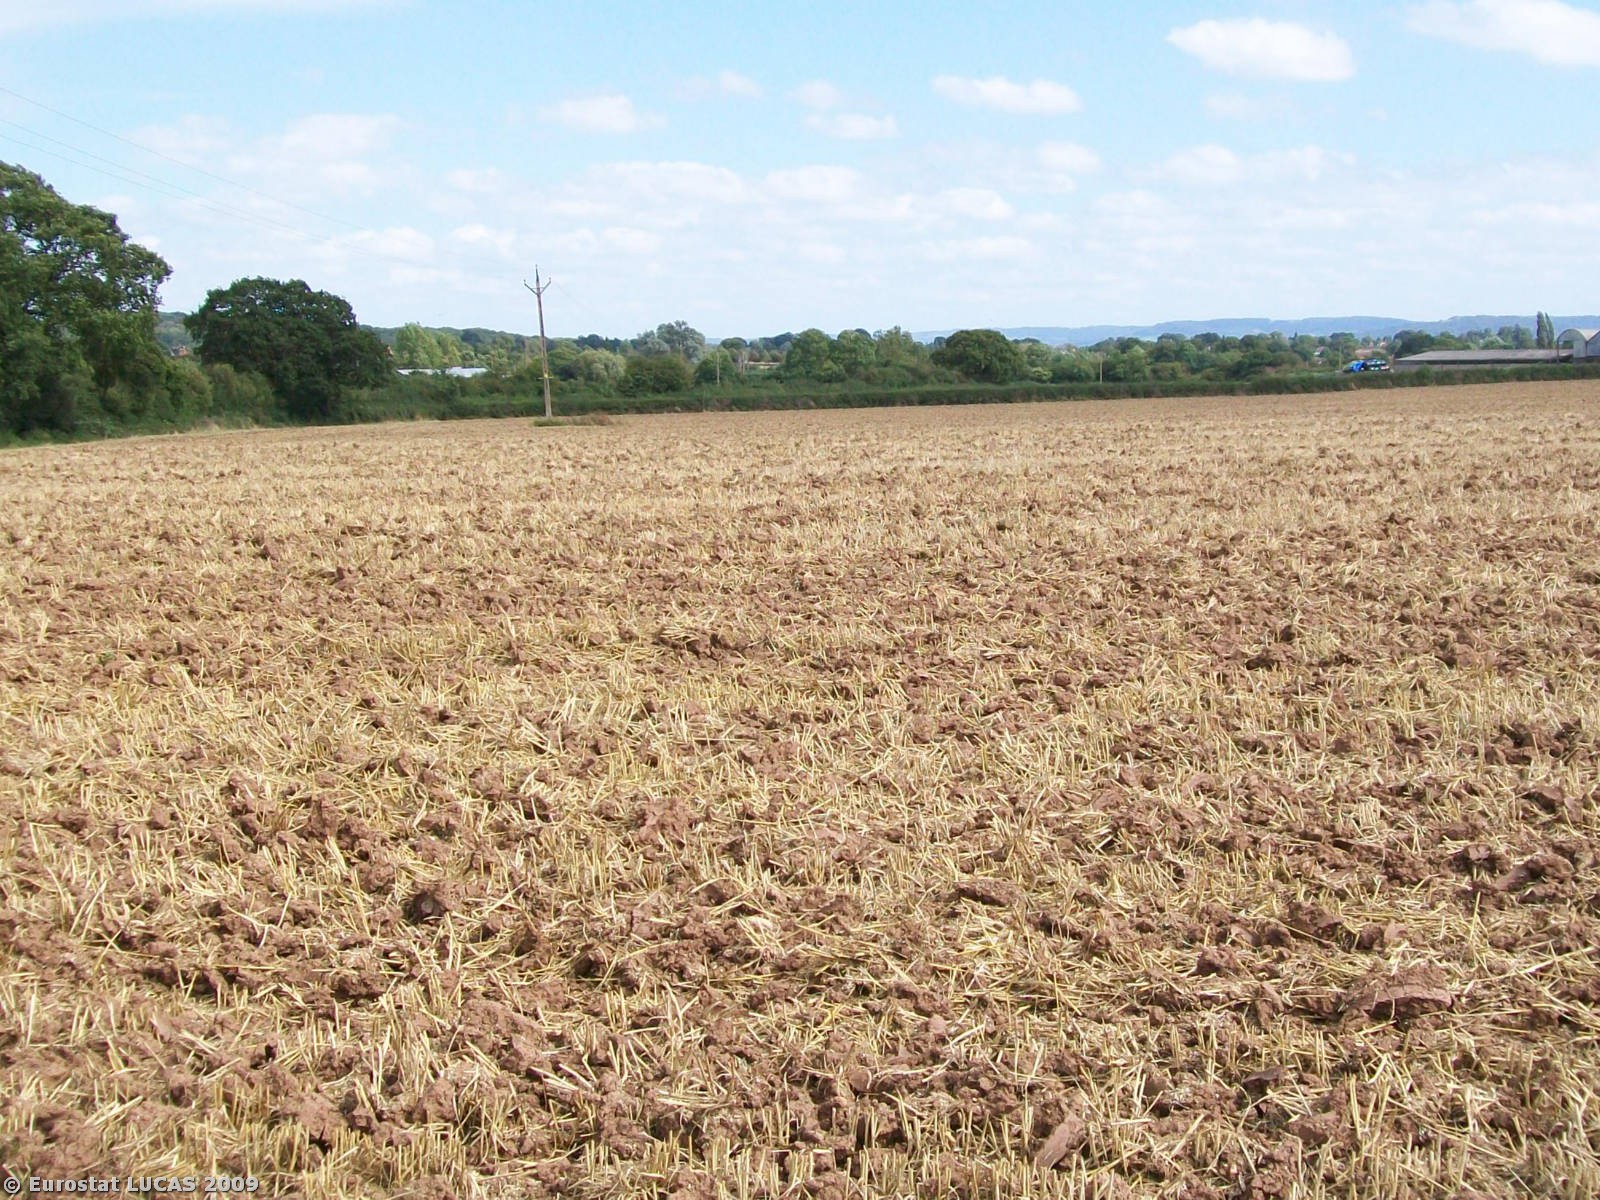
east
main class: Cropland
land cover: Common wheat
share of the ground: < 10 %
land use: Agriculture (excluding fallow land and kitchen gardens)
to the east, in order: Common wheat; Managed hedges; Grassland without tree/shrub cover; Abandoned hedges
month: August
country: GB
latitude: 51.8733
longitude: -2.3667
